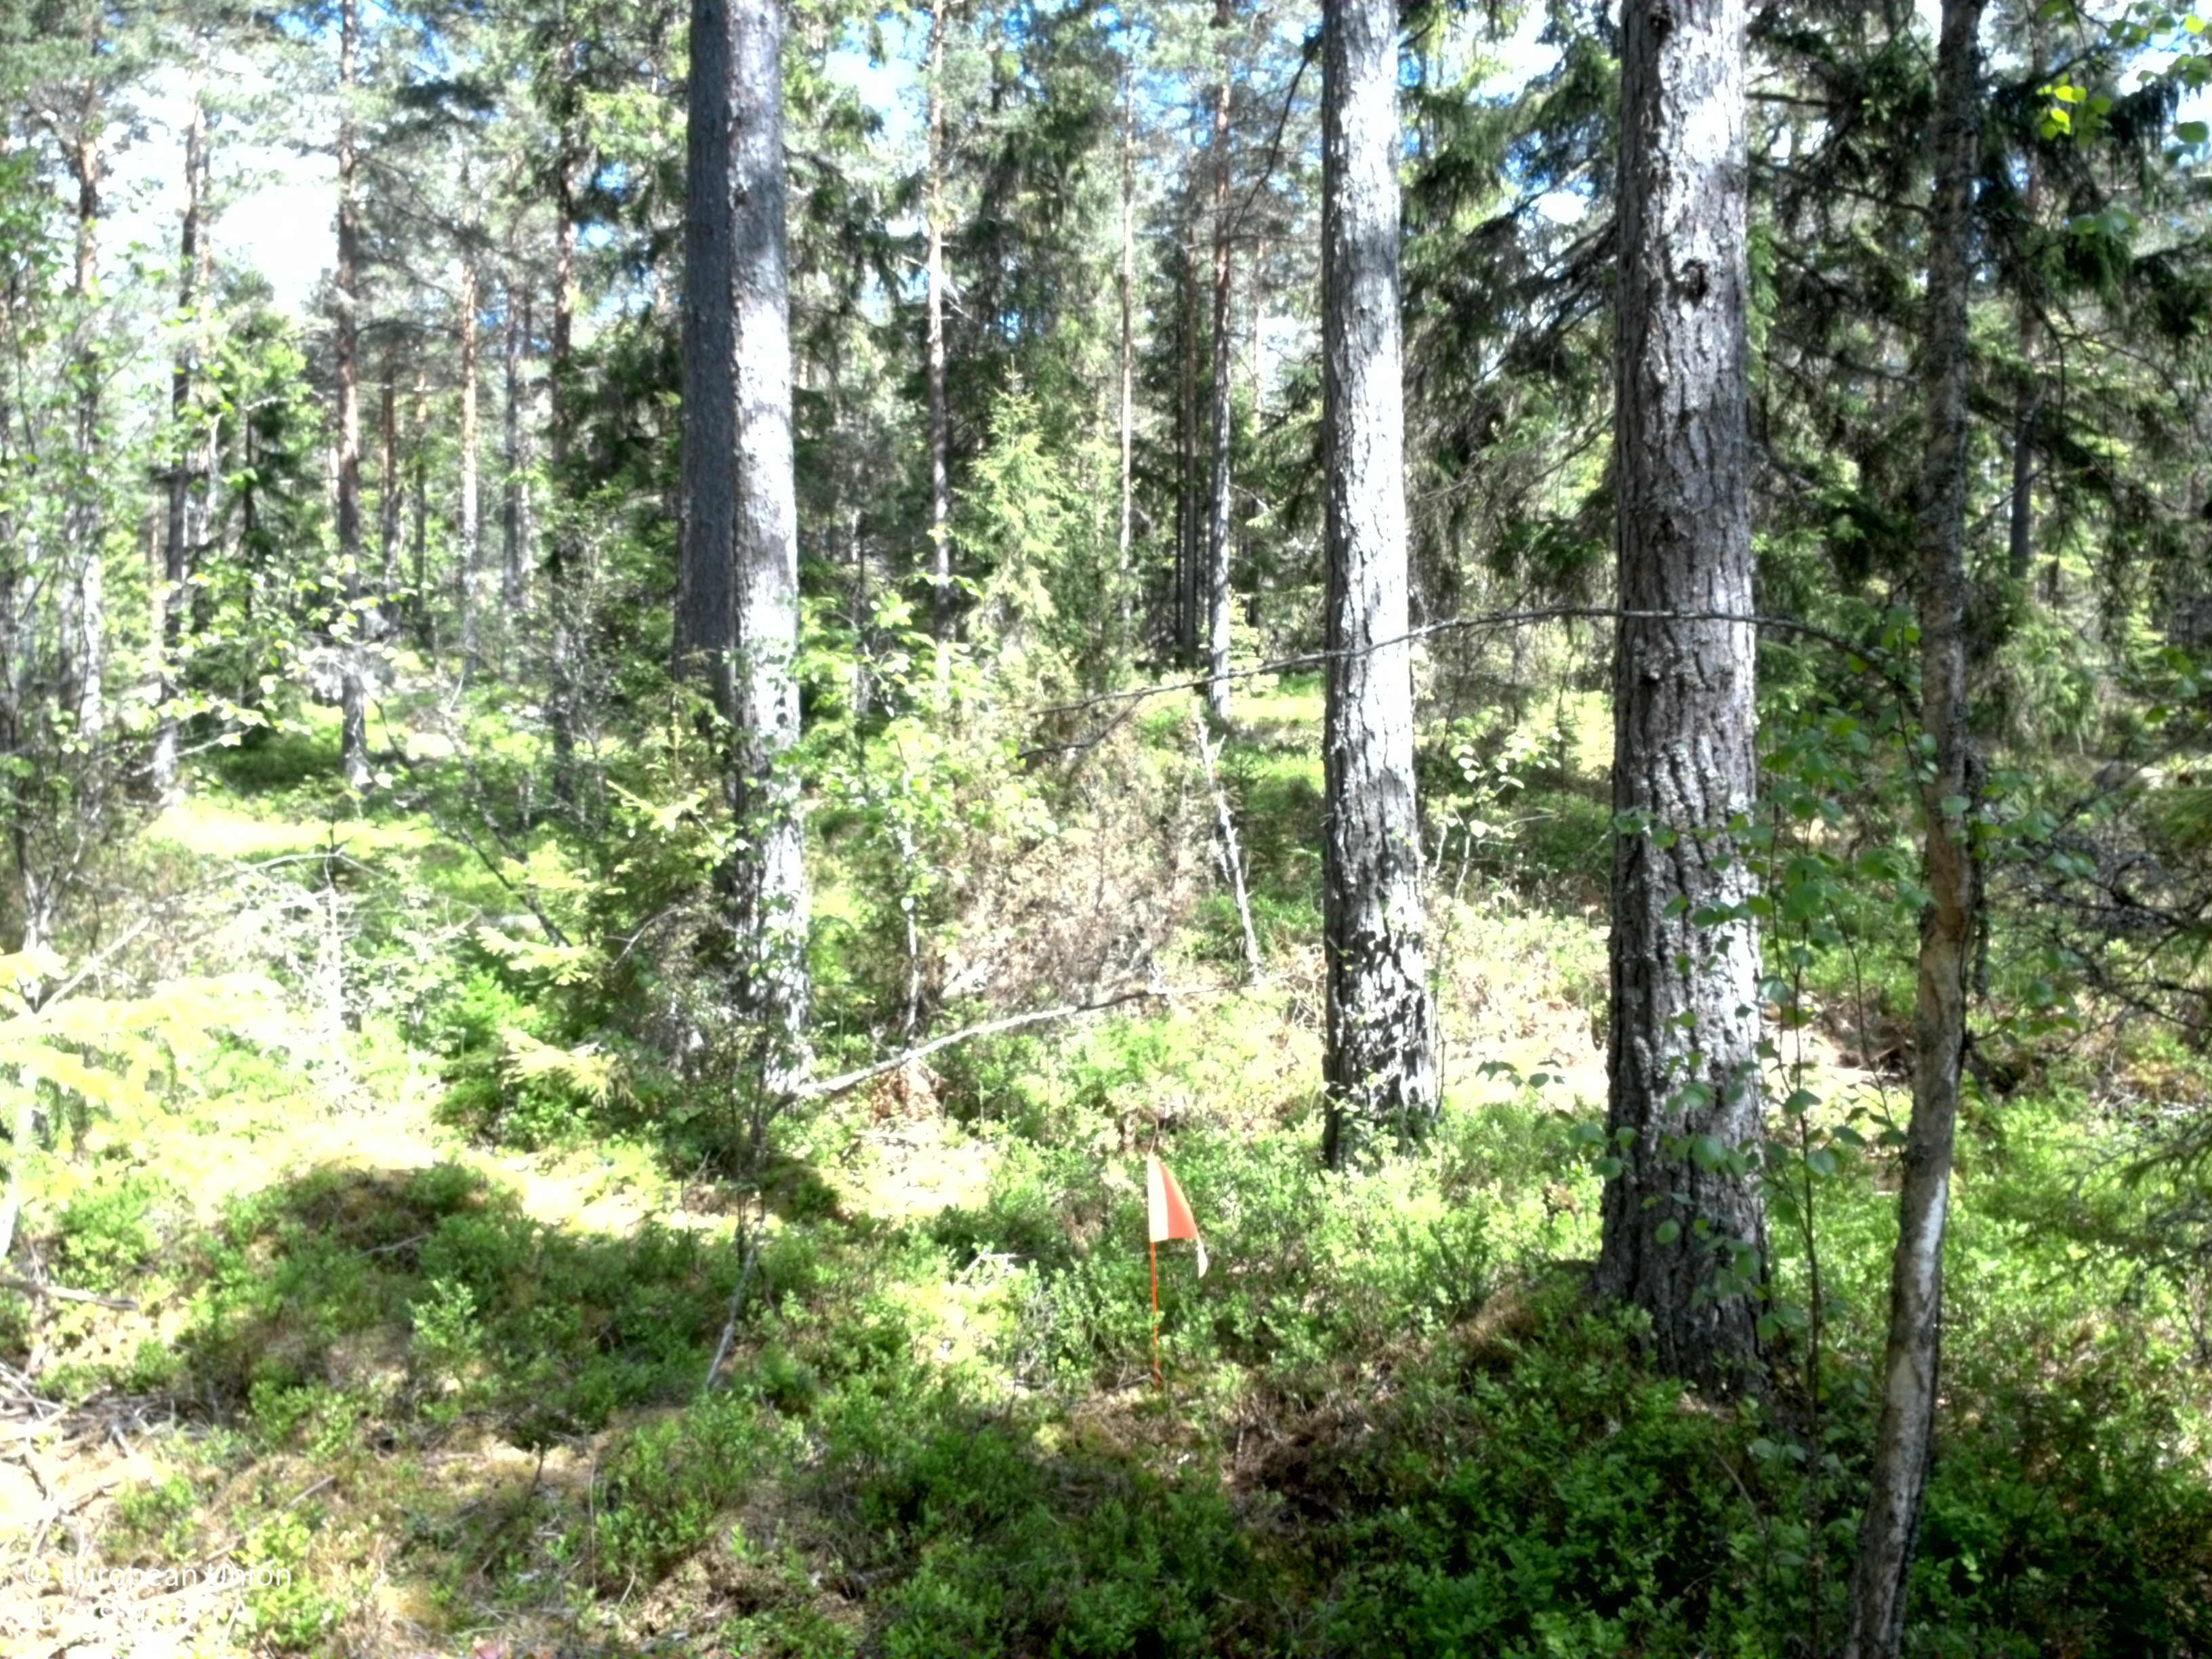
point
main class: Woodland
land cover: Pine dominated coniferous woodland
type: boreal forest
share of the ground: 25 - 50 %
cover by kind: coniferous forest trees 40 %, shrubs 30 %, broadleaved forest trees 10 %, herbaceous plants 10 %, lichens and mosses 10 %
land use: Forestry
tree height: > 5 m
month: May
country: SE
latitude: 57.3685
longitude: 15.9007
